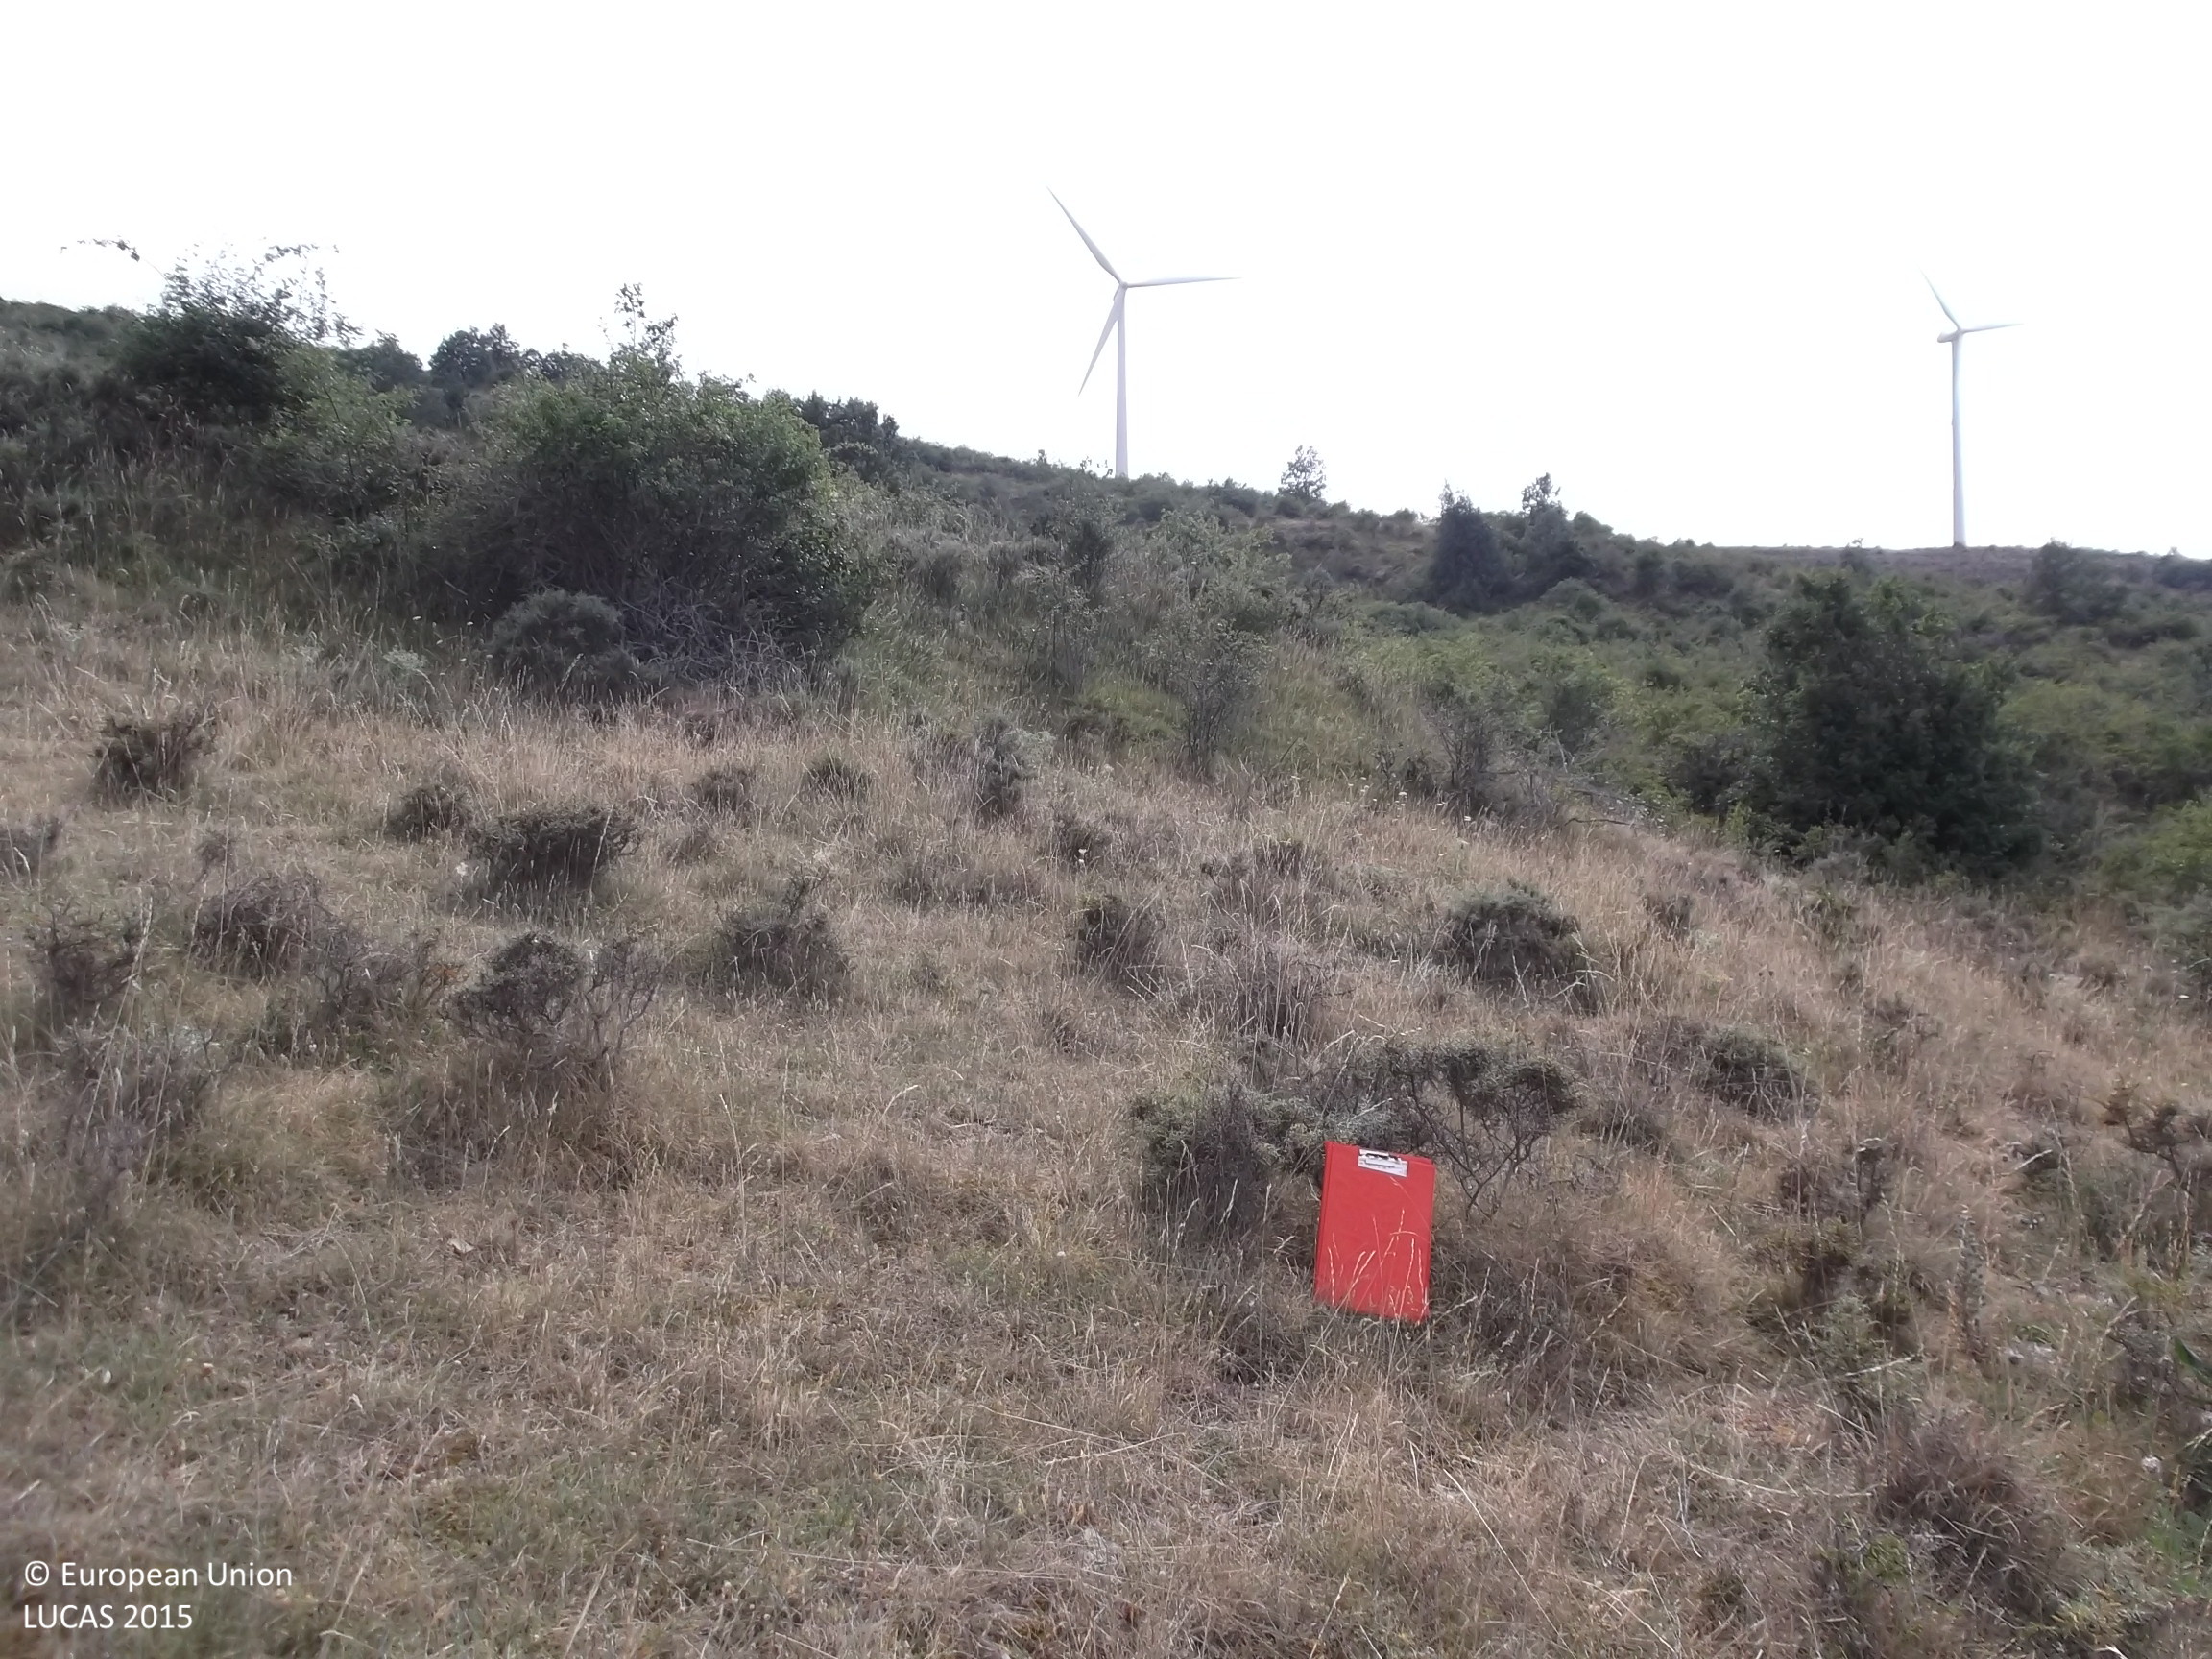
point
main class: Shrubland
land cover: Shrubland without tree cover
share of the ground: 25 - 50 %
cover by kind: shrubs 45 %, herbaceous plants 40 %, unconsolidated bare surface 10 %
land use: Abandoned areas
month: July
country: ES
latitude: 41.9817
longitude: -2.2397
